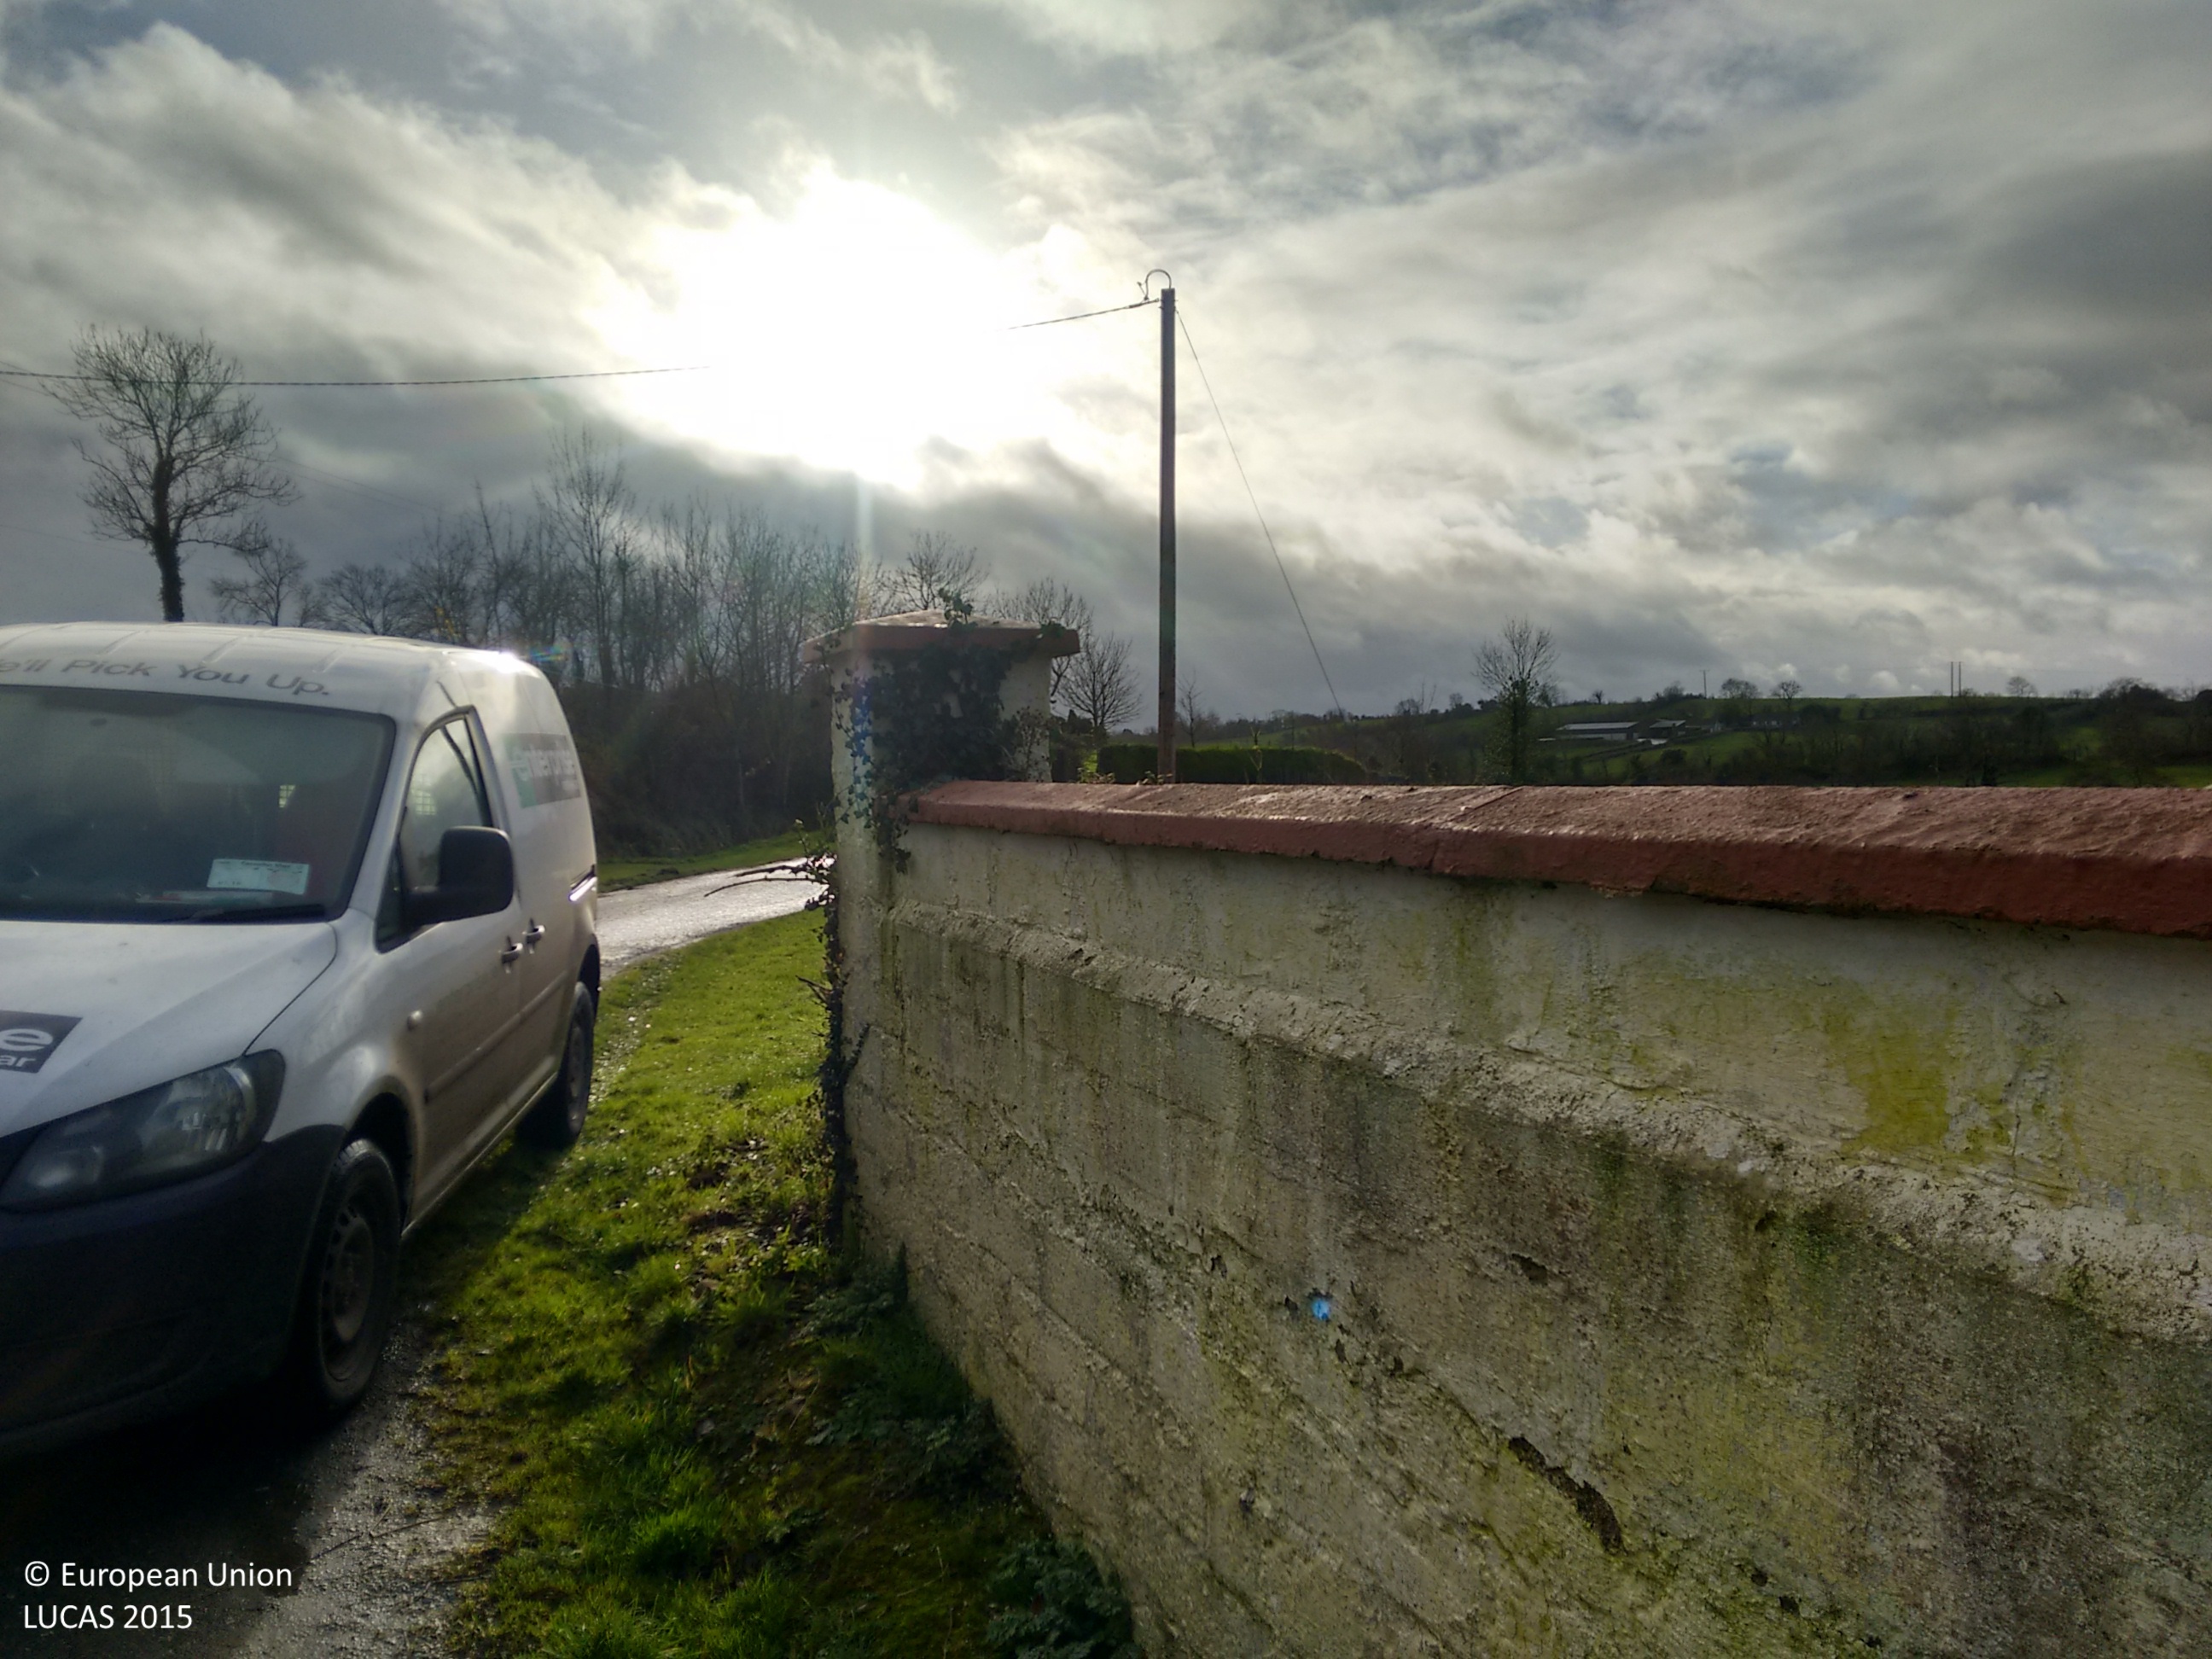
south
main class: Grassland
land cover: Grassland without tree/shrub cover
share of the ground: > 75 %
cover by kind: herbaceous plants 100 %
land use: Agriculture (excluding fallow land and kitchen gardens)
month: December
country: IE
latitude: 53.9334
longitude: -6.7507
